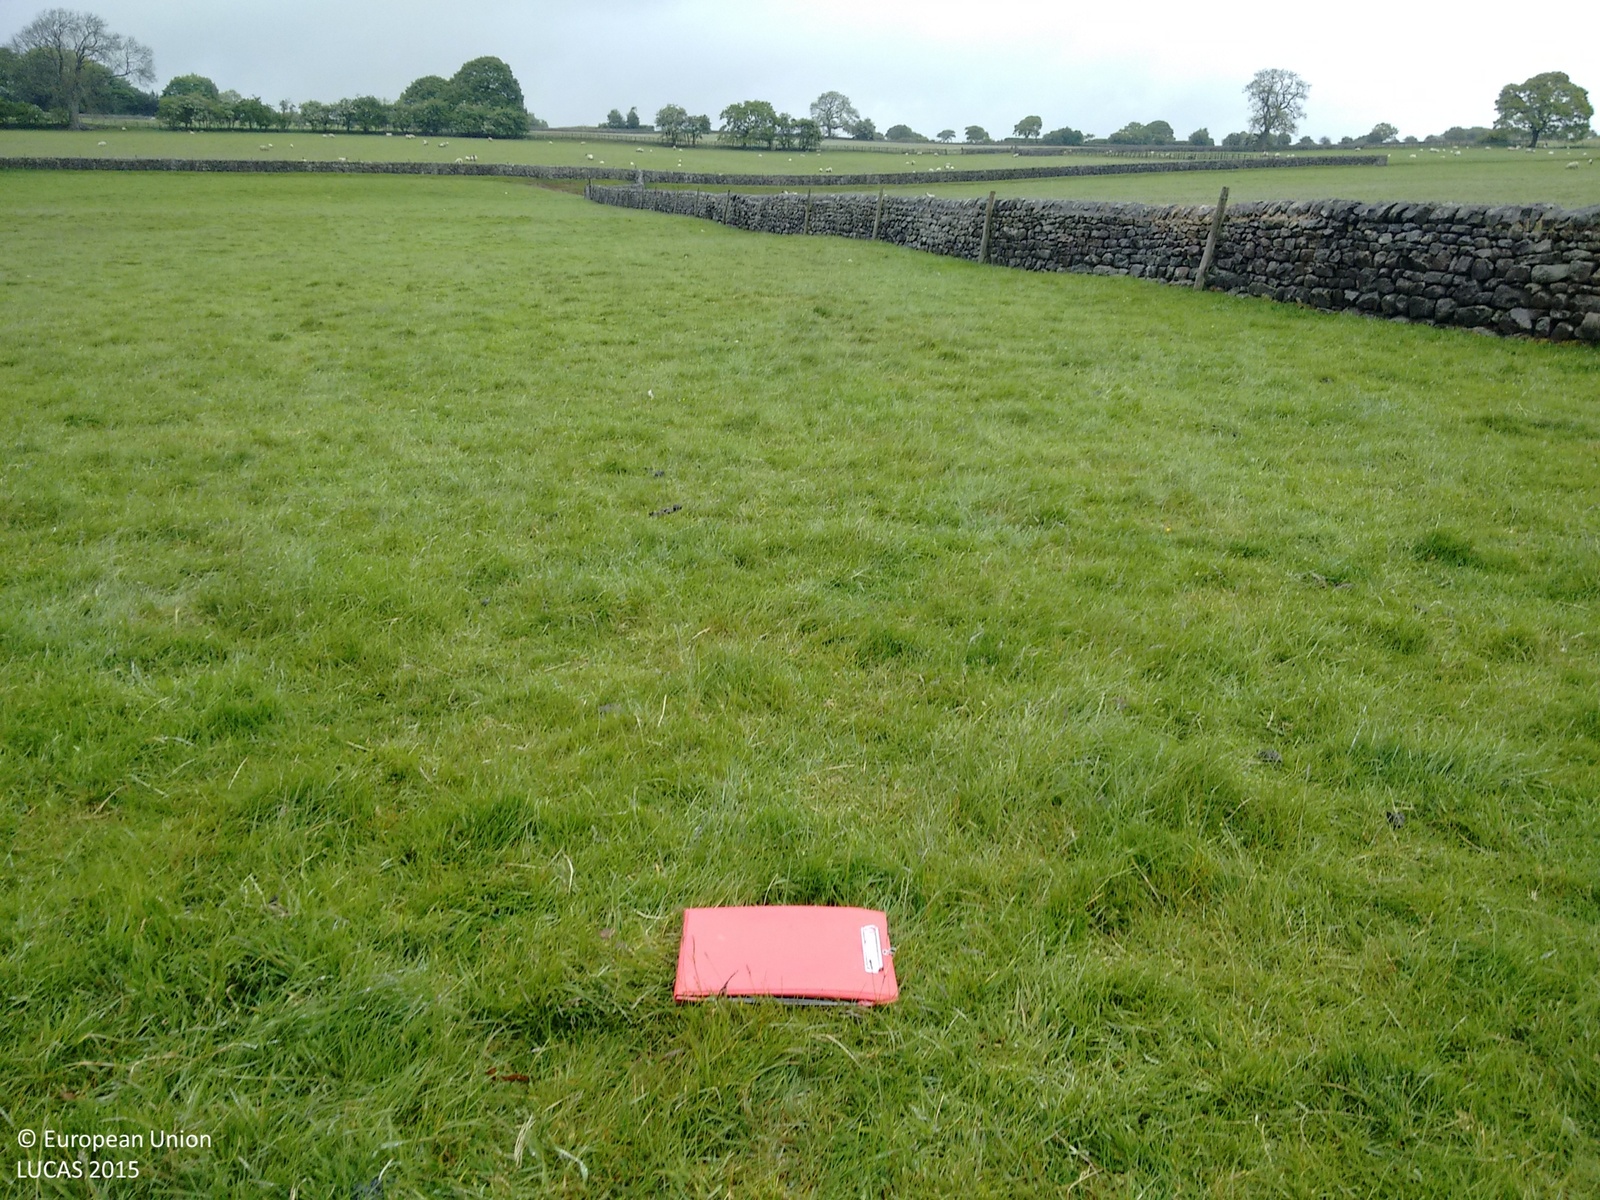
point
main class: Grassland
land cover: Grassland without tree/shrub cover
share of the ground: > 75 %
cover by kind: herbaceous plants 100 %
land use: Agriculture (excluding fallow land and kitchen gardens)
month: May
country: GB
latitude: 53.9316
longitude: -1.6111
